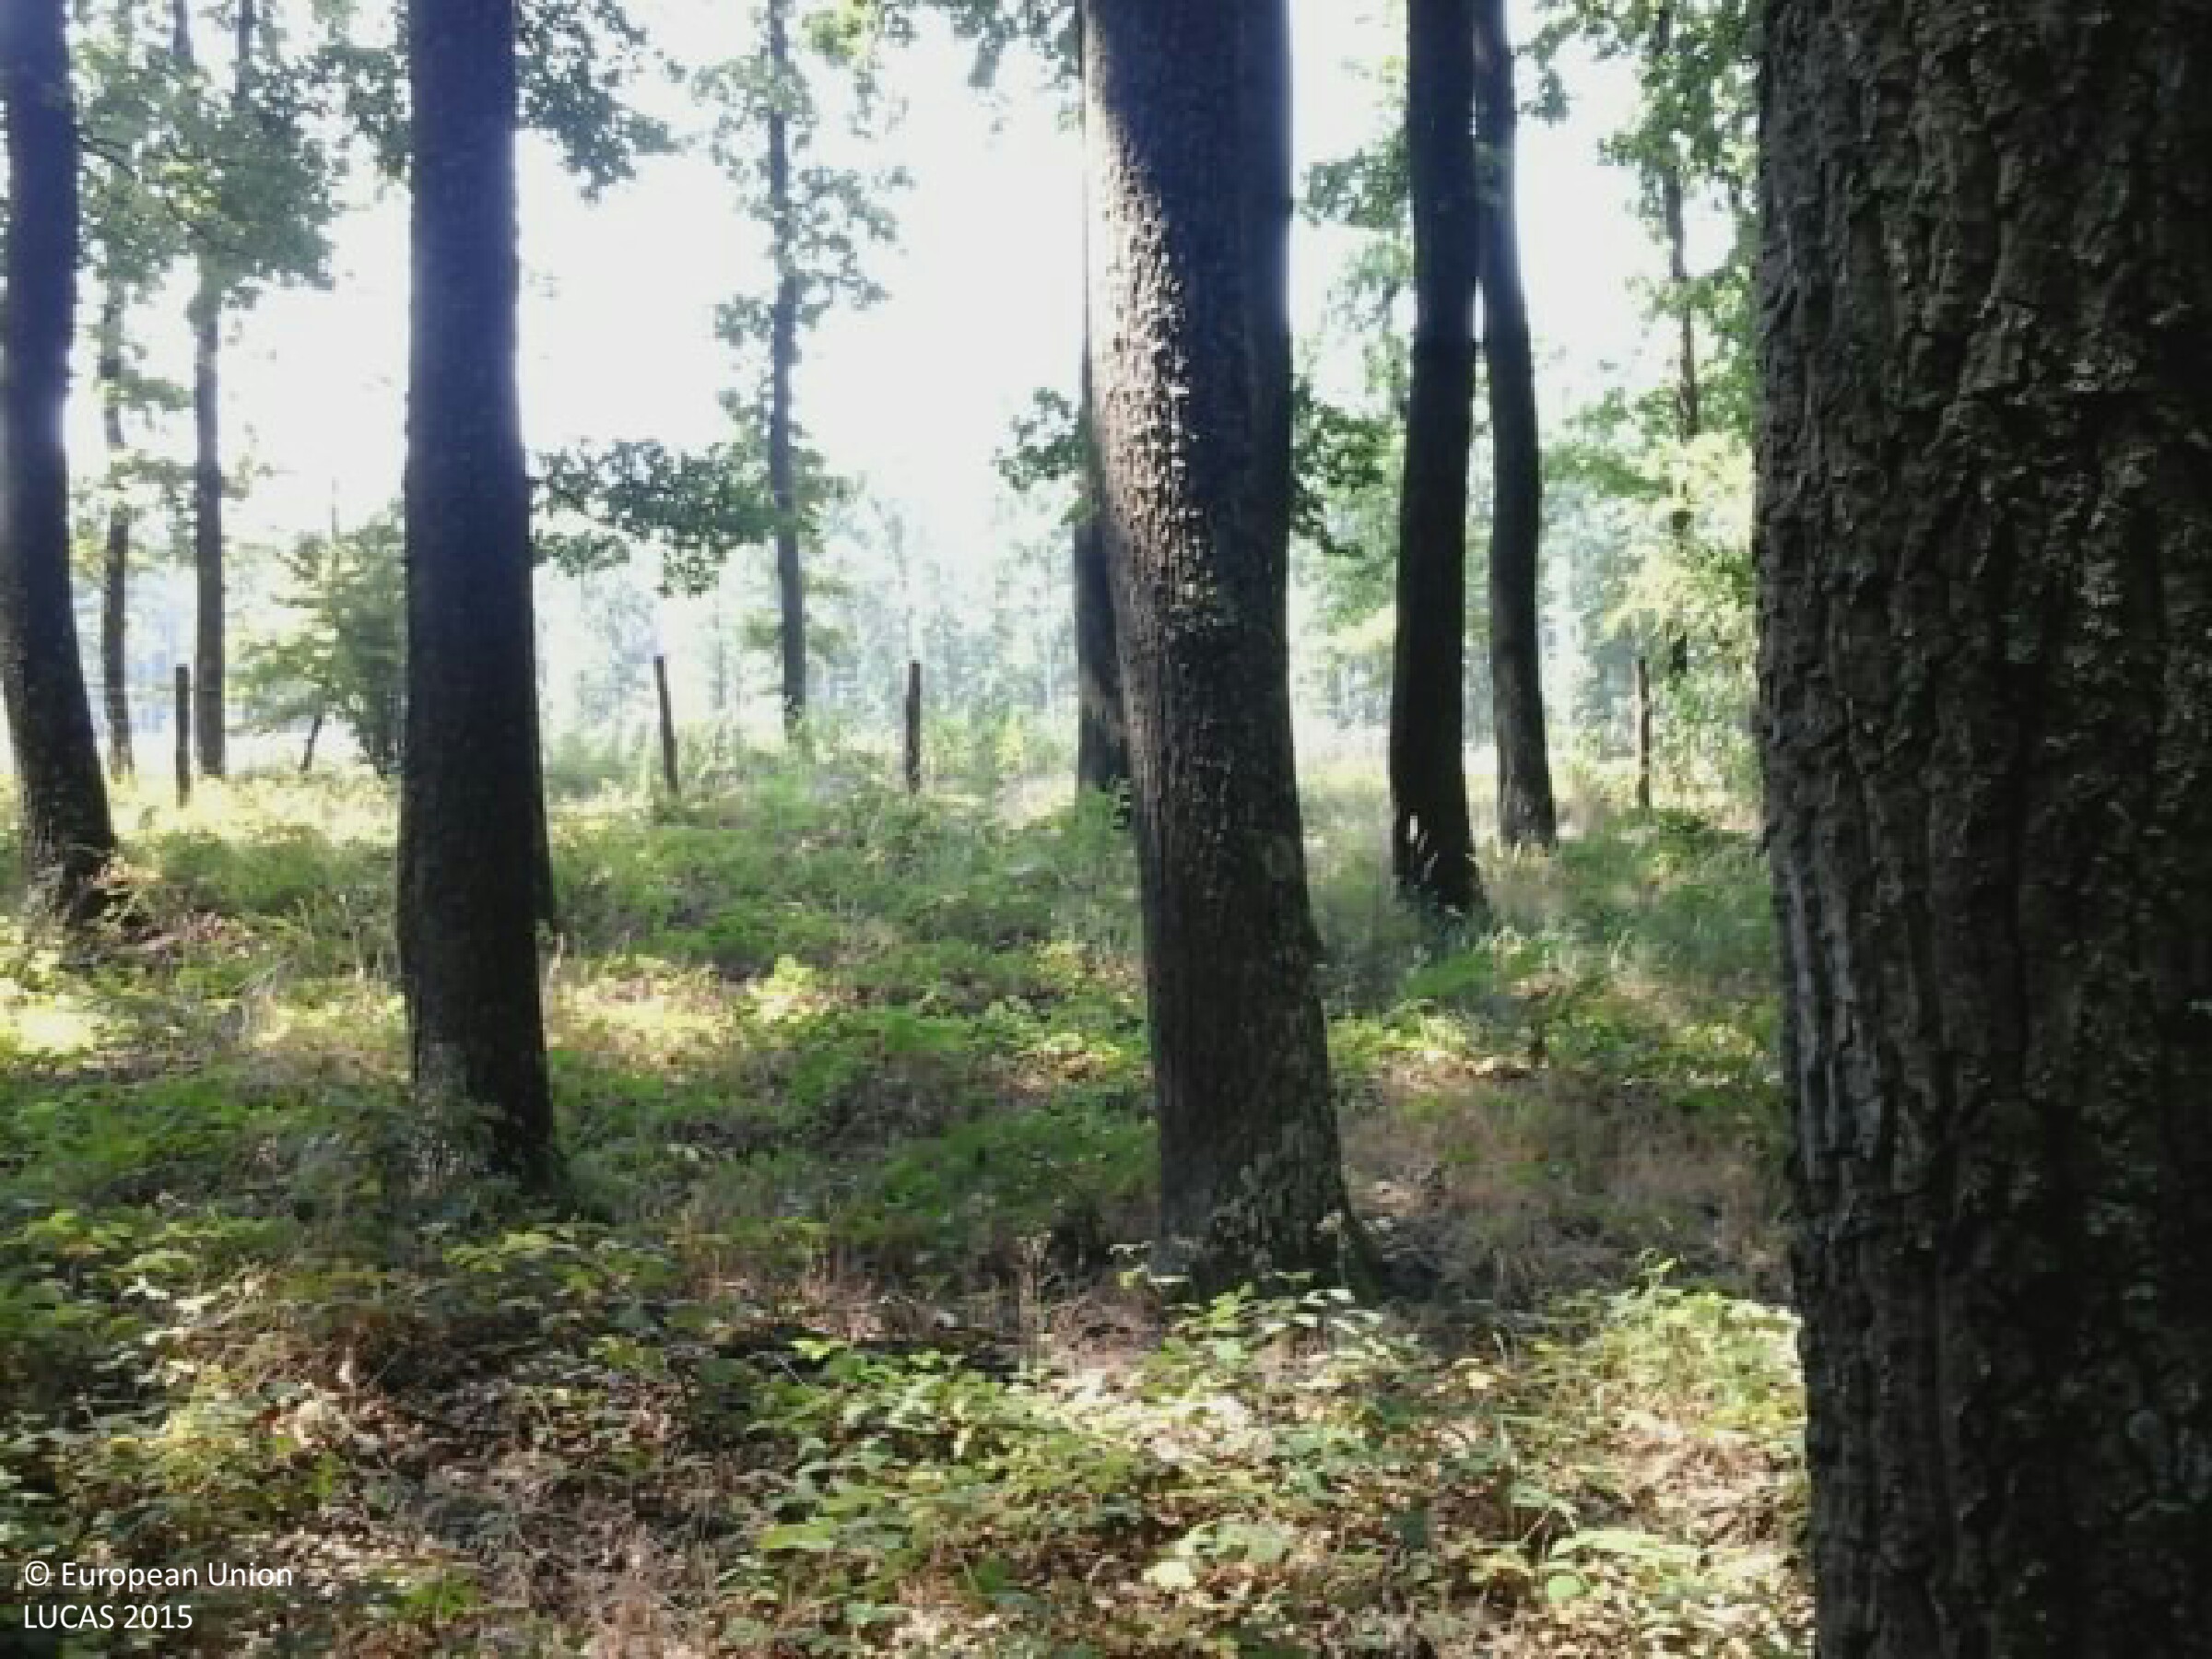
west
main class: Woodland
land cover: Broadleaved woodland
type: mesophytic deciduous forest
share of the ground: > 75 %
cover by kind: broadleaved forest trees 95 %, shrubs 5 %
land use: Forestry
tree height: > 5 m
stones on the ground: < 10 %
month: August
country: HU
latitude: 46.1957
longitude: 17.2465
